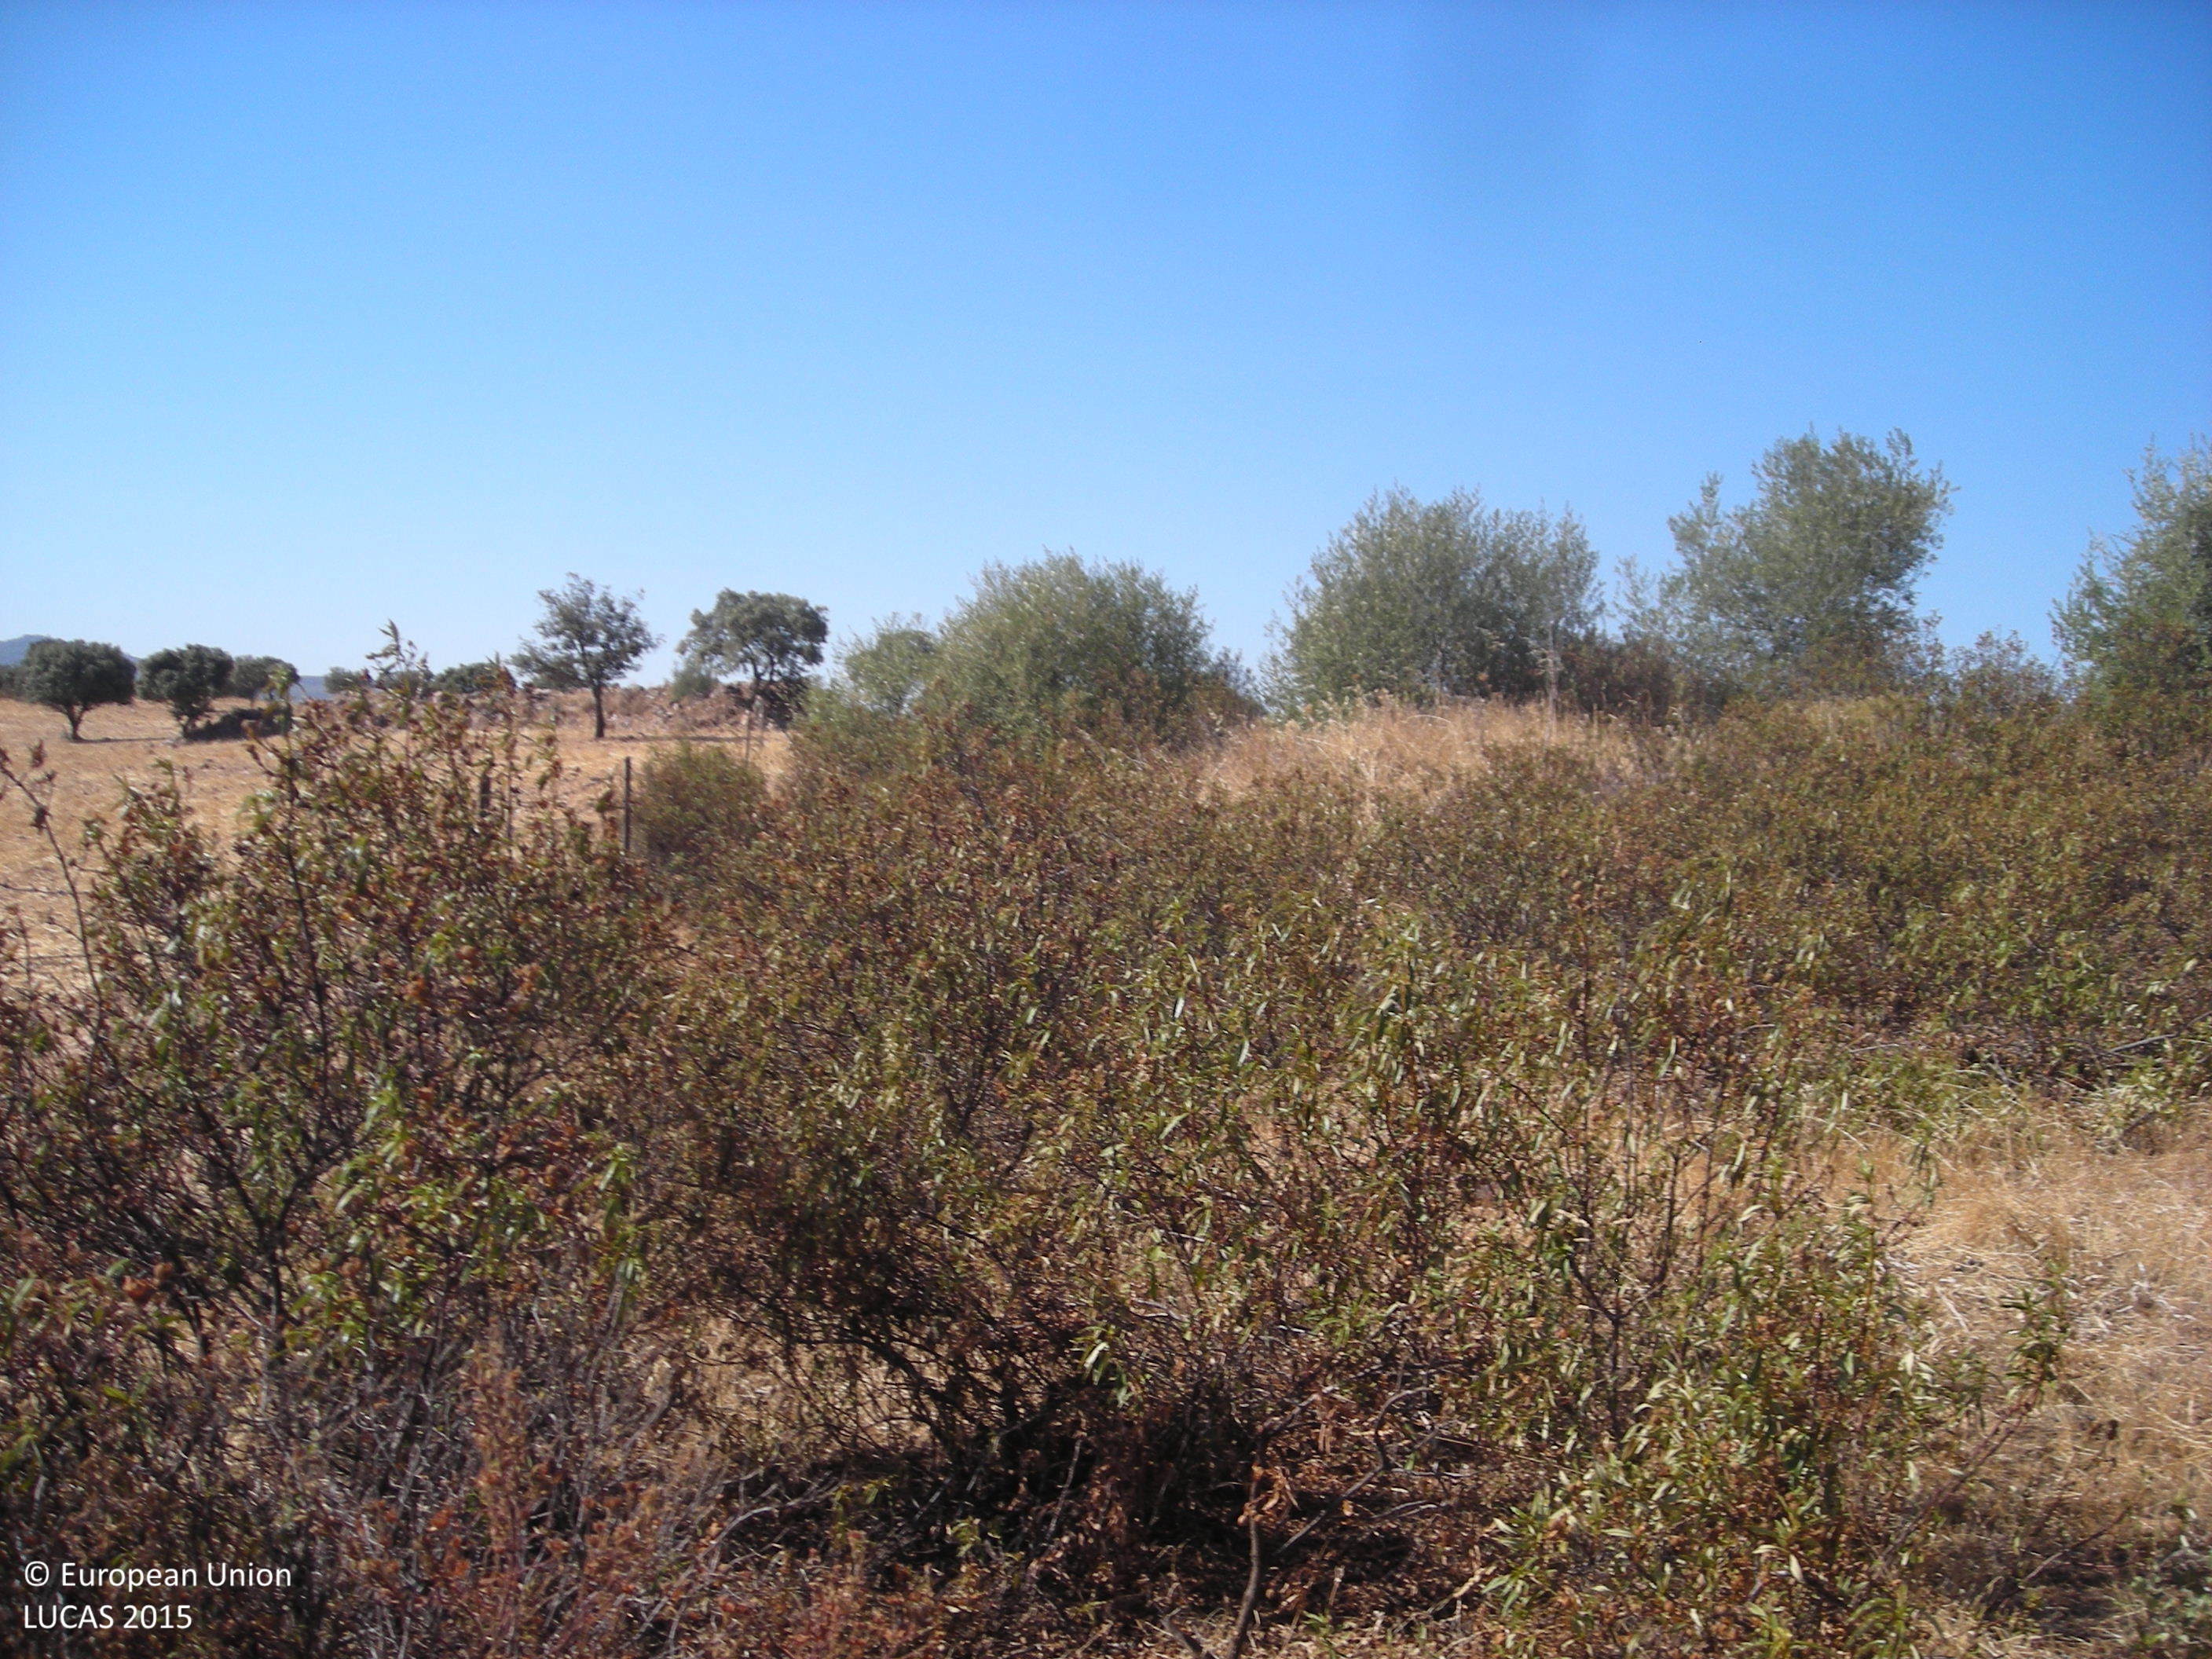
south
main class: Woodland
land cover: Broadleaved woodland
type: broadleaved evergreen forest
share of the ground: 25 - 50 %
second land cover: Grassland without tree/shrub cover
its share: 50 - 75 %
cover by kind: herbaceous plants 60 %, broadleaved forest trees 40 %
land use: Forestry
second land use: Agriculture (excluding fallow land and kitchen gardens)
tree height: > 5 m
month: July
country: ES
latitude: 38.8598
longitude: -5.8468
